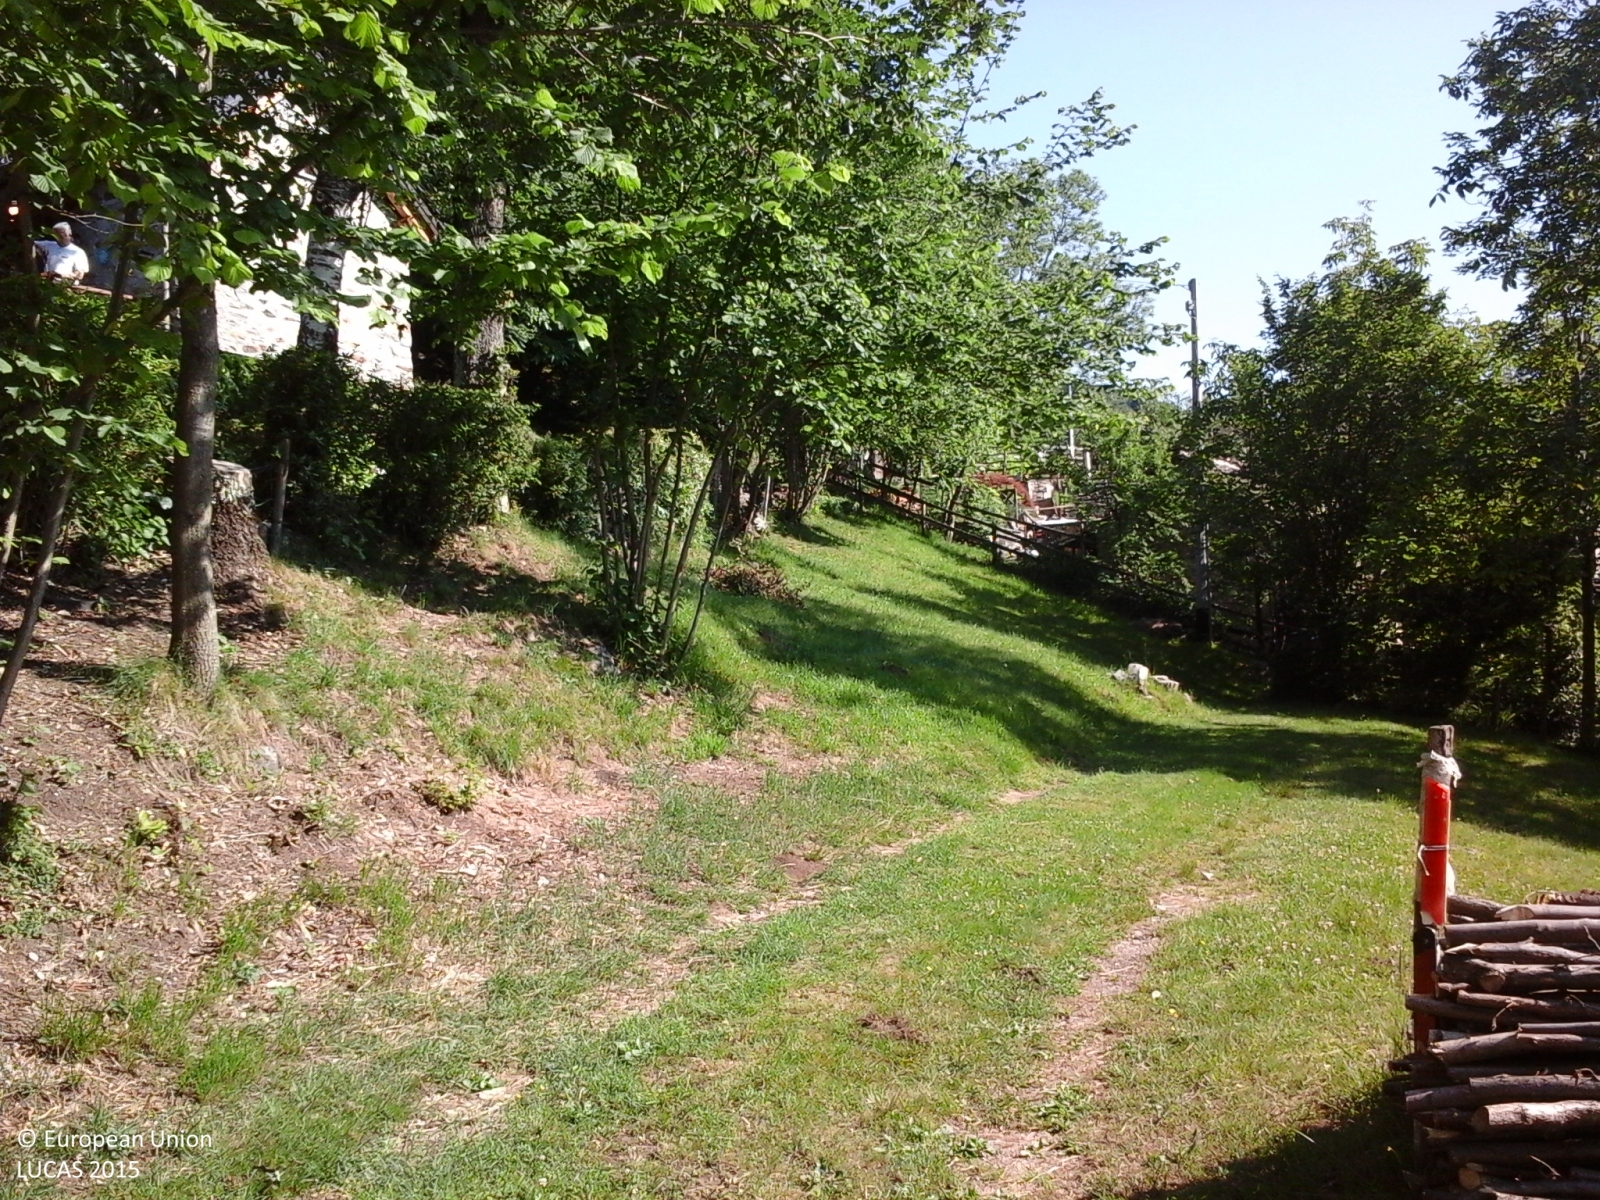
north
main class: Woodland
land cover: Broadleaved woodland
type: mesophytic deciduous forest
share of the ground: > 75 %
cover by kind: broadleaved forest trees 100 %
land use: Forestry
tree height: > 5 m
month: June
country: IT
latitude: 45.9799
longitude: 8.4662
